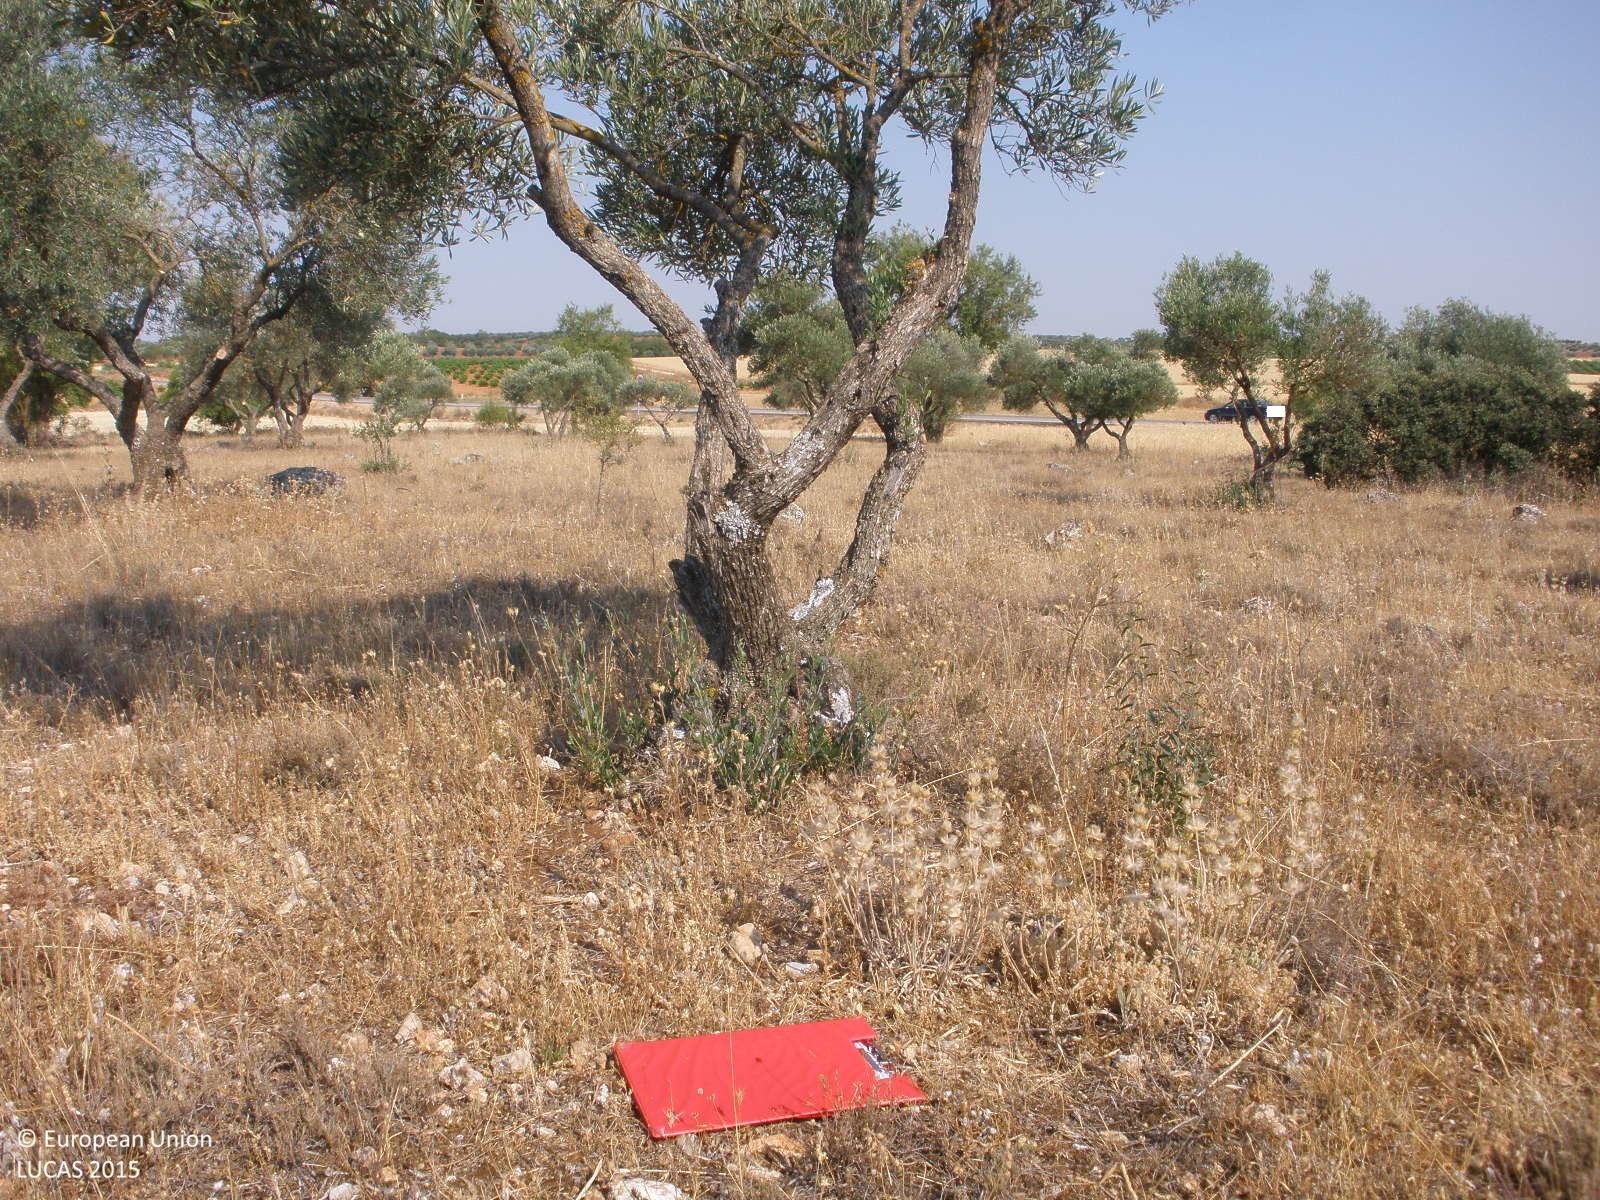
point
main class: Cropland
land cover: Olive groves
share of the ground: 25 - 50 %
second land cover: Shrubland without tree cover
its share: 10 - 25 %
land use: Agriculture (excluding fallow land and kitchen gardens)
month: June
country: ES
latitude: 40.2863
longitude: -3.3346
